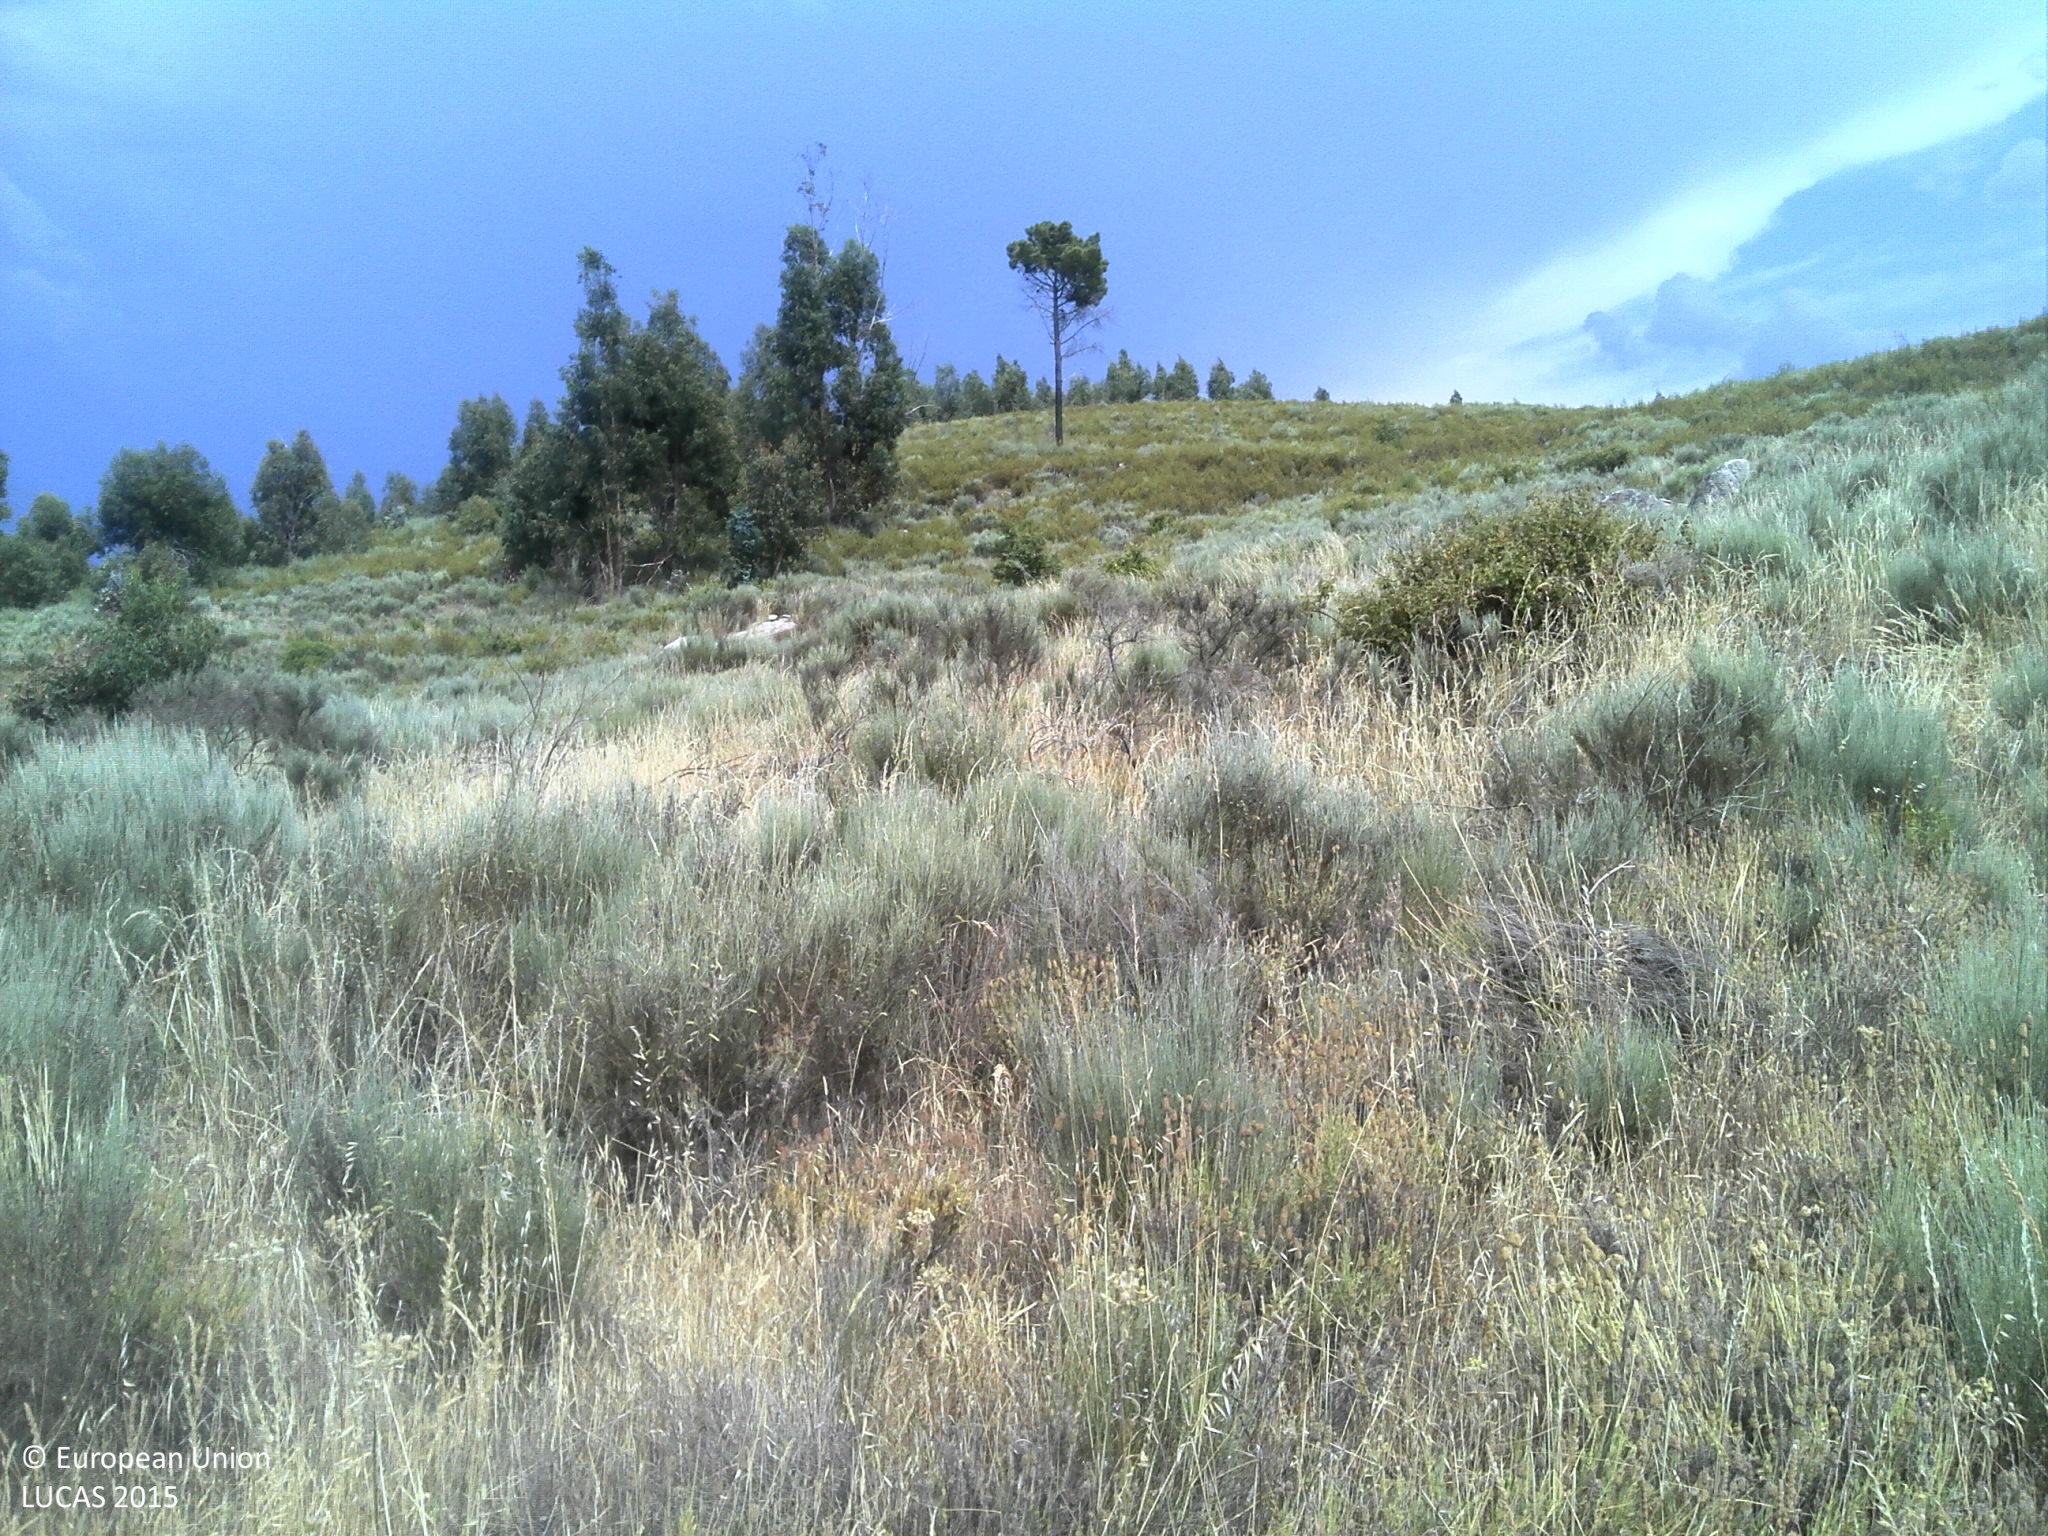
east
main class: Shrubland
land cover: Shrubland without tree cover
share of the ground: 50 - 75 %
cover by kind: shrubs 55 %, herbaceous plants 25 %, unconsolidated bare surface 20 %
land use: Abandoned areas
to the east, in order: Shrubland without tree cover; Shrubland with sparse tree cover; Shrubland without tree cover; Broadleaved woodland; Tracks; Broadleaved woodland; Tracks; Broadleaved woodland
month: June
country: PT
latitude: 40.3053
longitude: -7.2924
